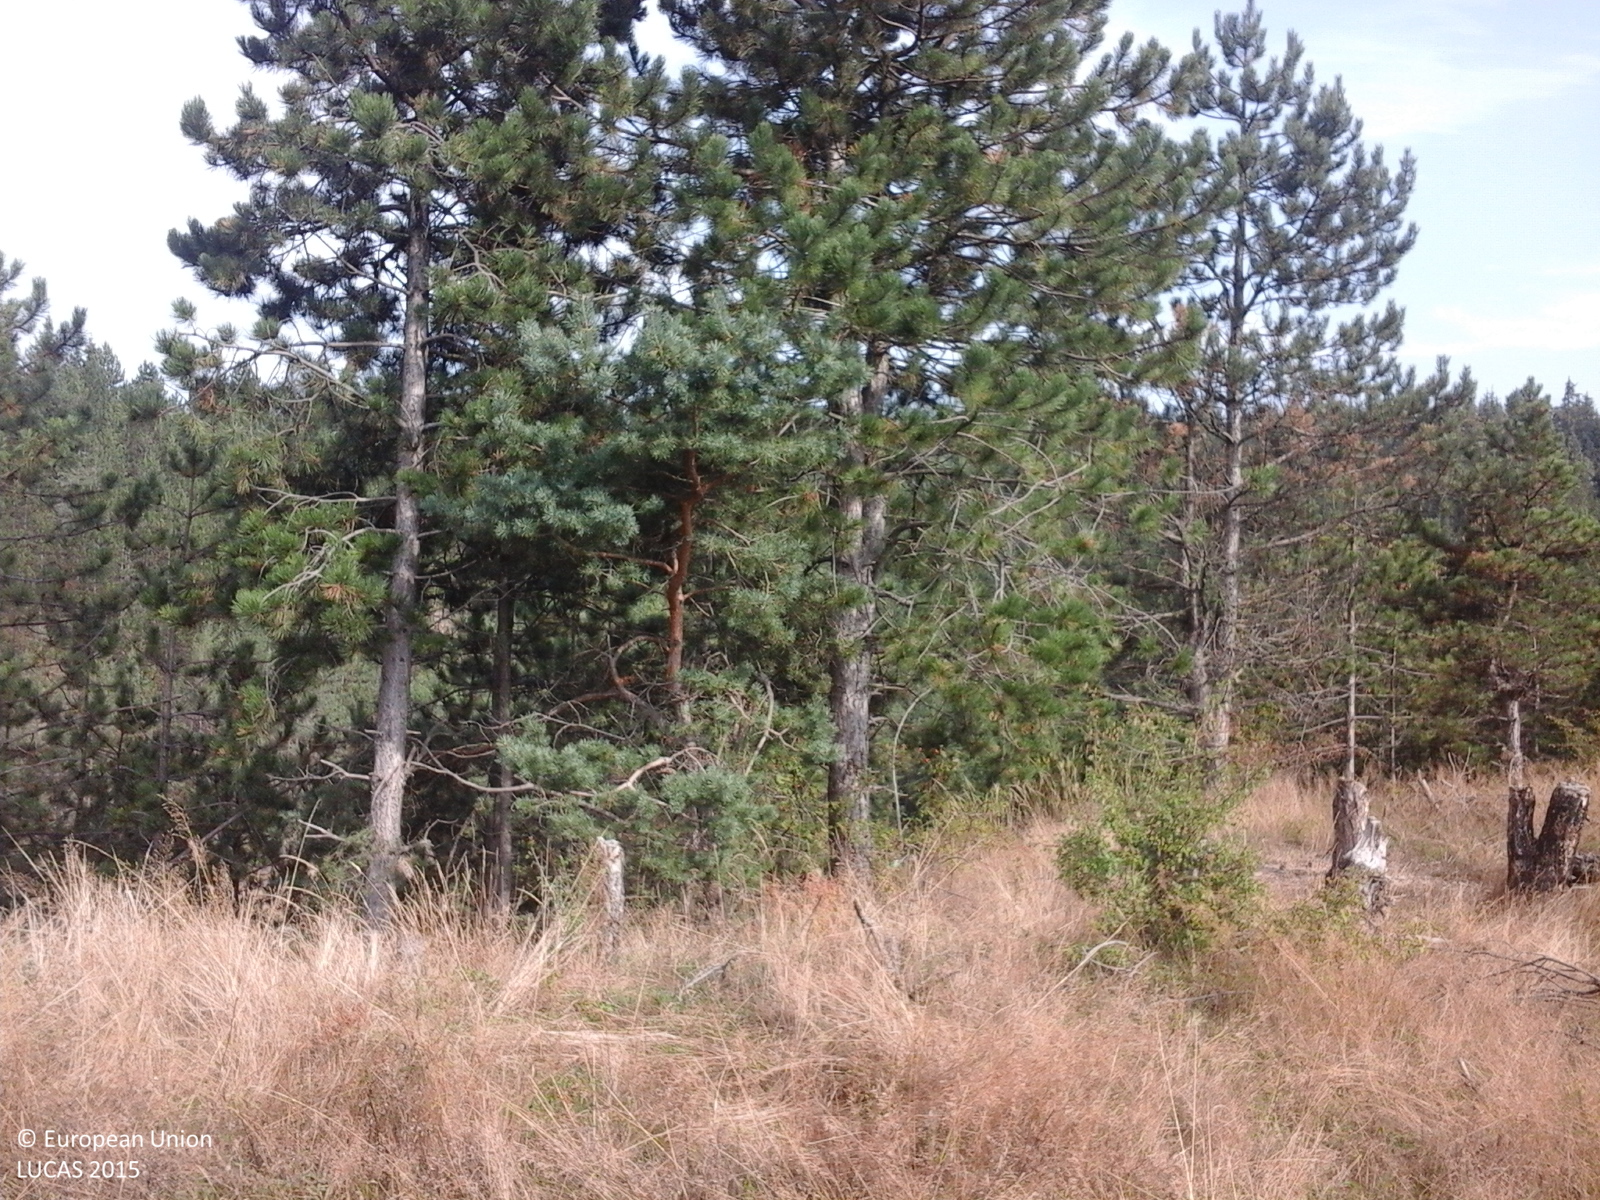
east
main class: Grassland
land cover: Grassland without tree/shrub cover
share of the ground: > 75 %
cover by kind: herbaceous plants 100 %
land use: Agriculture (excluding fallow land and kitchen gardens)
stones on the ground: < 10 %
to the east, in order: Grassland without tree/shrub cover; Spruce dominated coniferous woodland; Artificial constructions in urban areas; Inland fresh running water; Spontaneously vegetated surfaces; Abandoned hedges; Paved roads, cycling and walking lanes; Spruce dominated mixed woodland; Other coniferous woodland; Grassland without tree/shrub cover
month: September
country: RO
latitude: 46.7561
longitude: 23.0087
